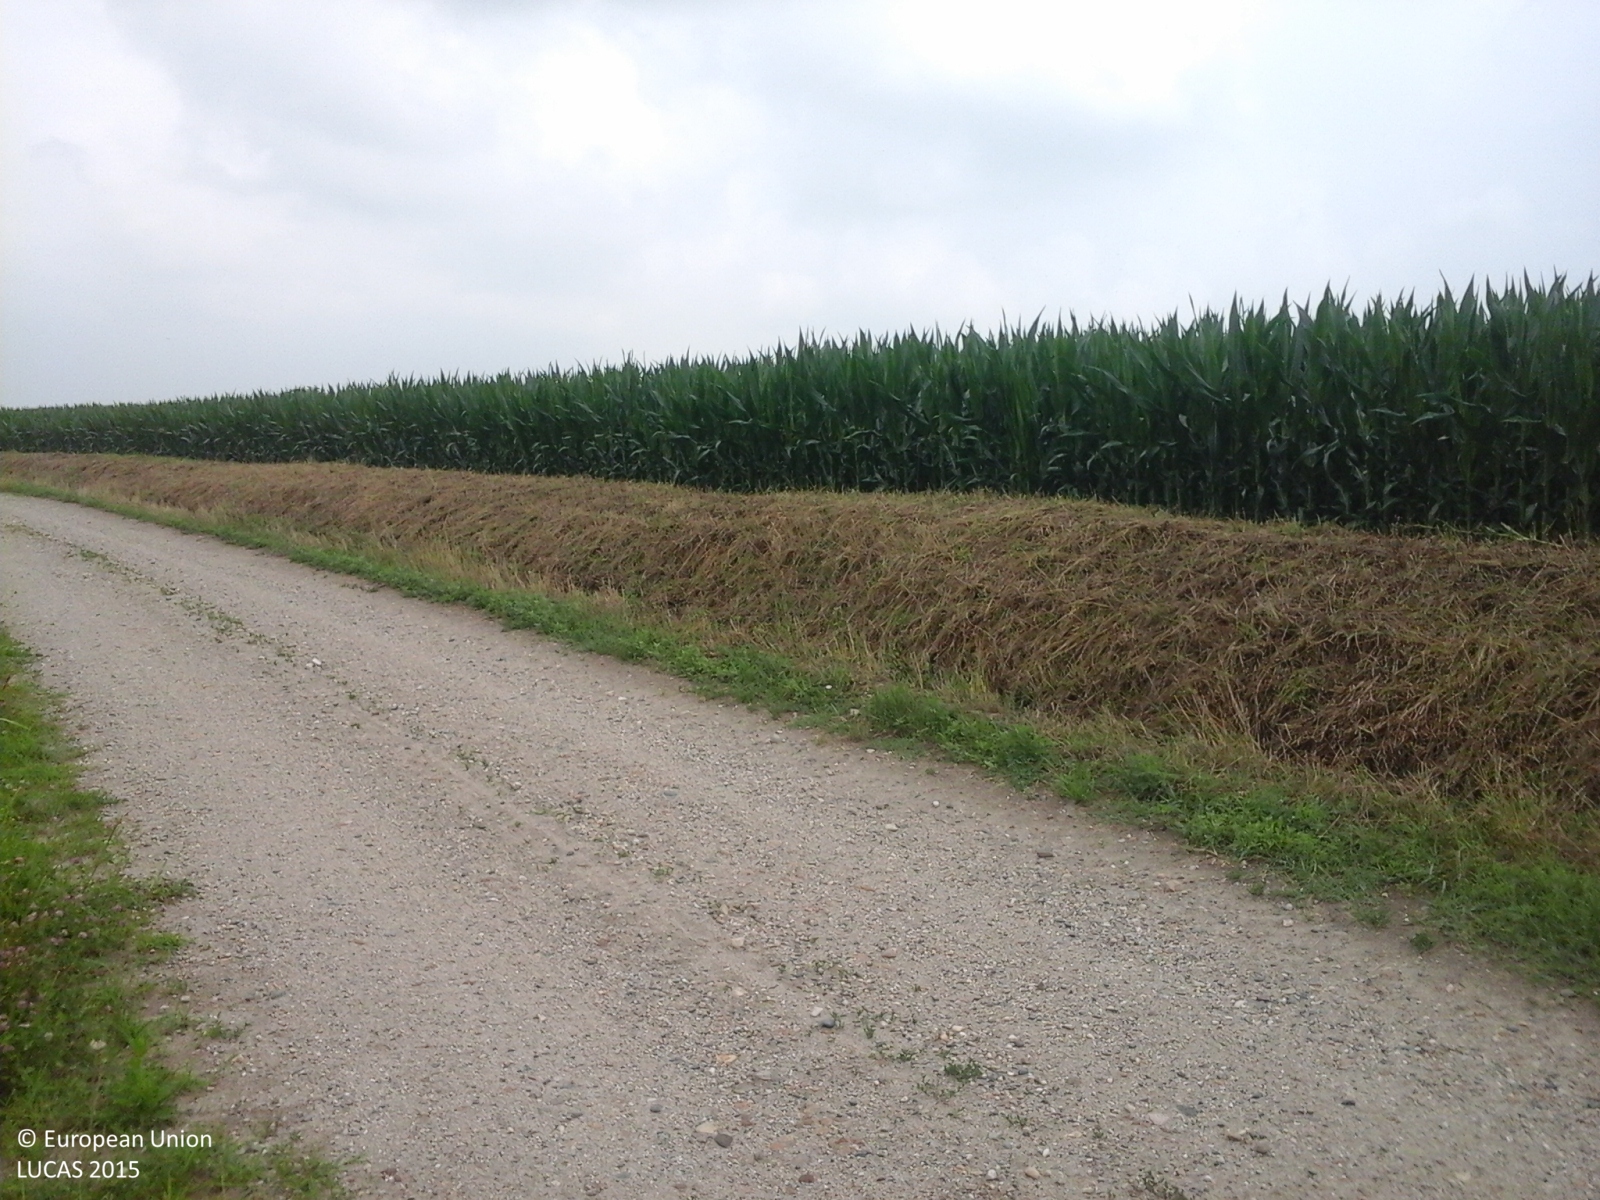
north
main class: Cropland
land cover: Rice
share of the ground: > 75 %
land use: Agriculture (excluding fallow land and kitchen gardens)
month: June
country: IT
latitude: 45.2242
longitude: 8.5634
